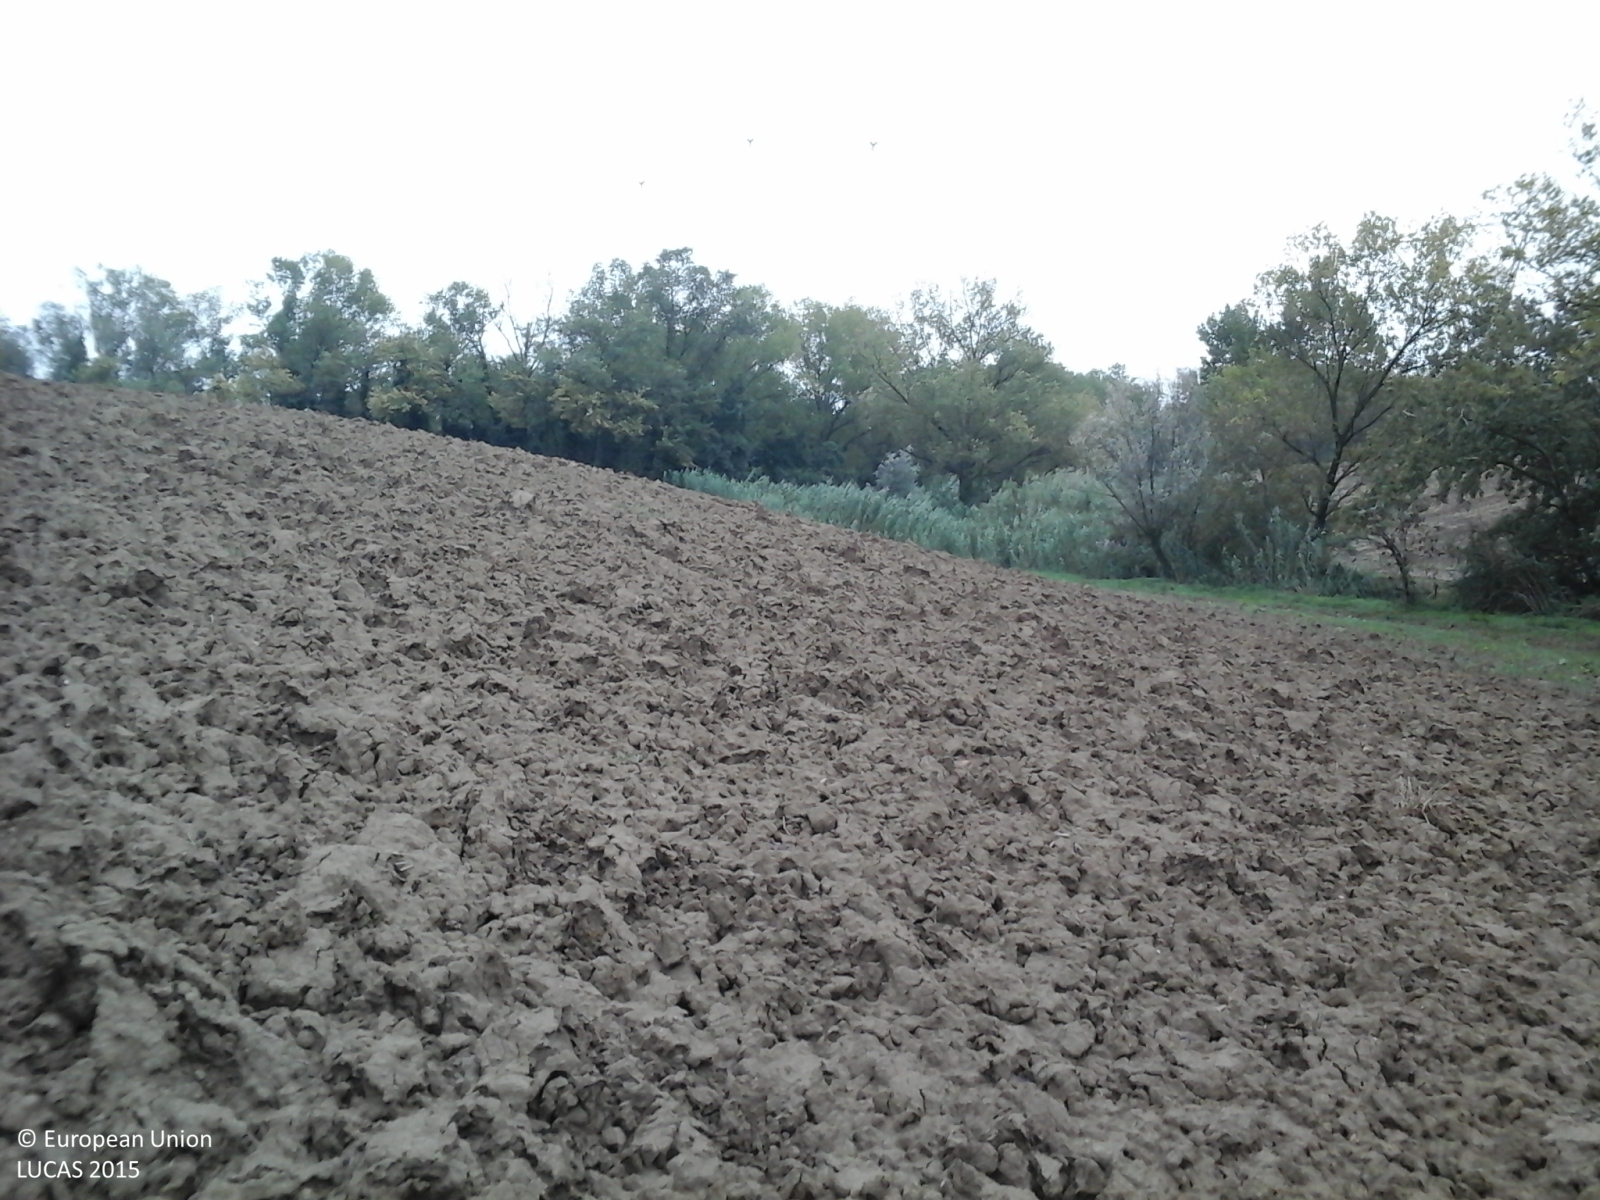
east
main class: Cropland
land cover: Durum wheat
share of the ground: < 10 %
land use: Agriculture (excluding fallow land and kitchen gardens)
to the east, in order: Durum wheat; Electric lines; Durum wheat; Shrubland without tree cover; Ditches and canals; Broadleaved woodland; Ditches and canals; Broadleaved woodland
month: October
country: IT
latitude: 43.6316
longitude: 13.2519
